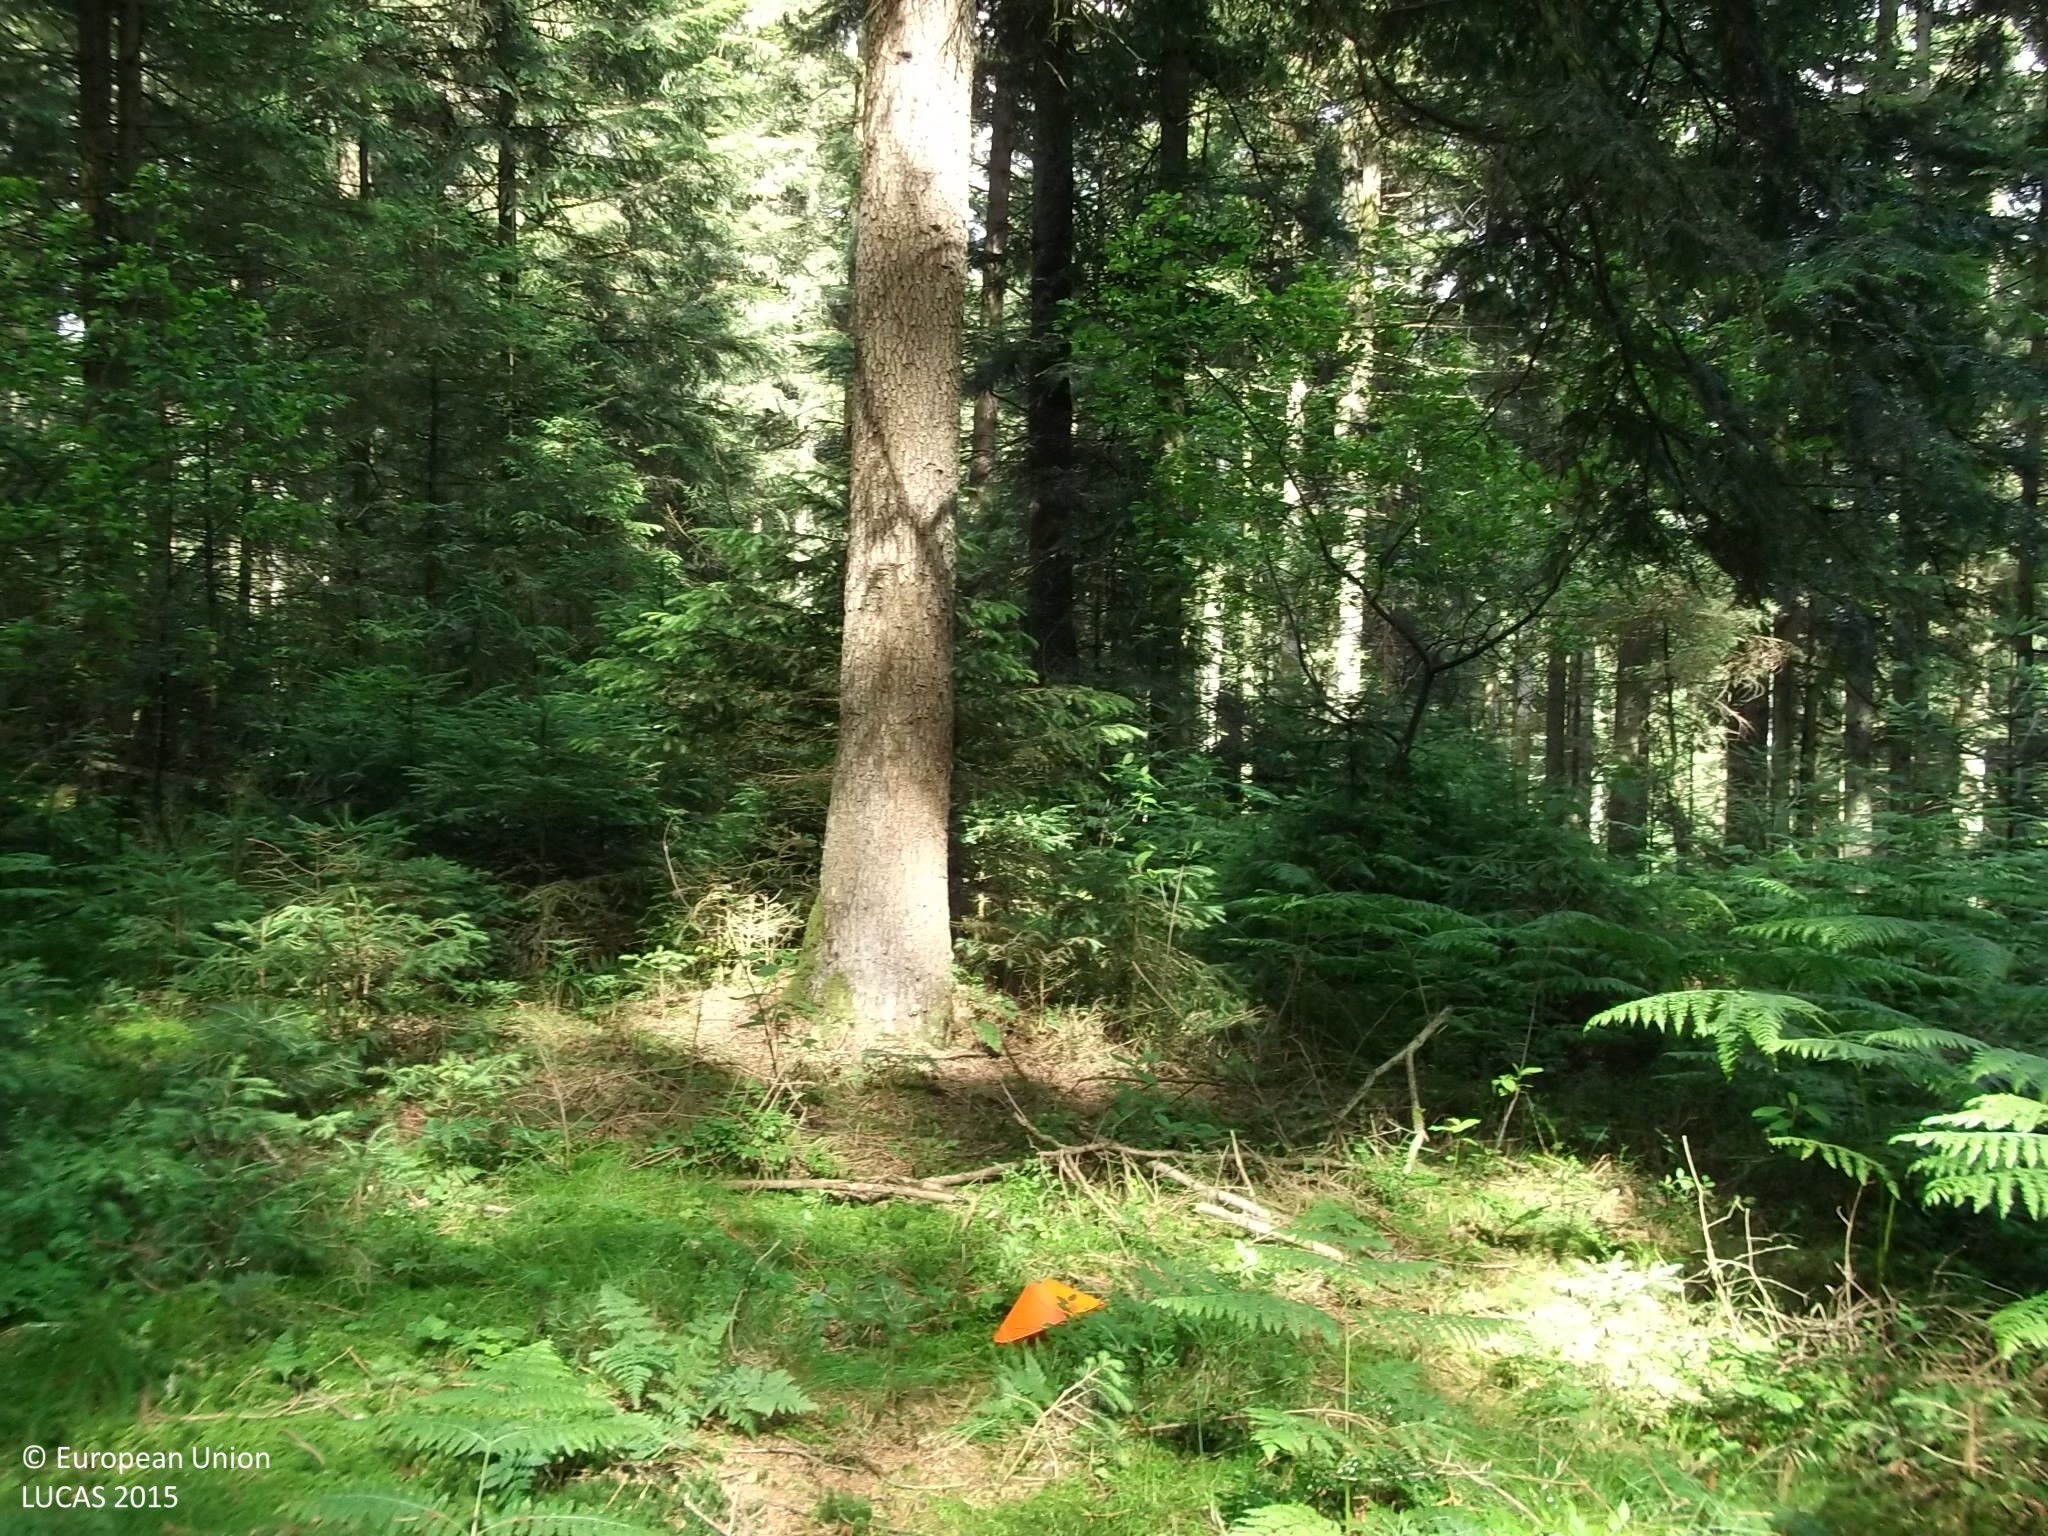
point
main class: Woodland
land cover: Spruce dominated coniferous woodland
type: alpine coniferous forest
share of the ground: > 75 %
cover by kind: coniferous forest trees 75 %, herbaceous plants 20 %, broadleaved forest trees 5 %
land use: Forestry
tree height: > 5 m
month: June
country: AT
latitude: 48.0093
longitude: 13.3904
